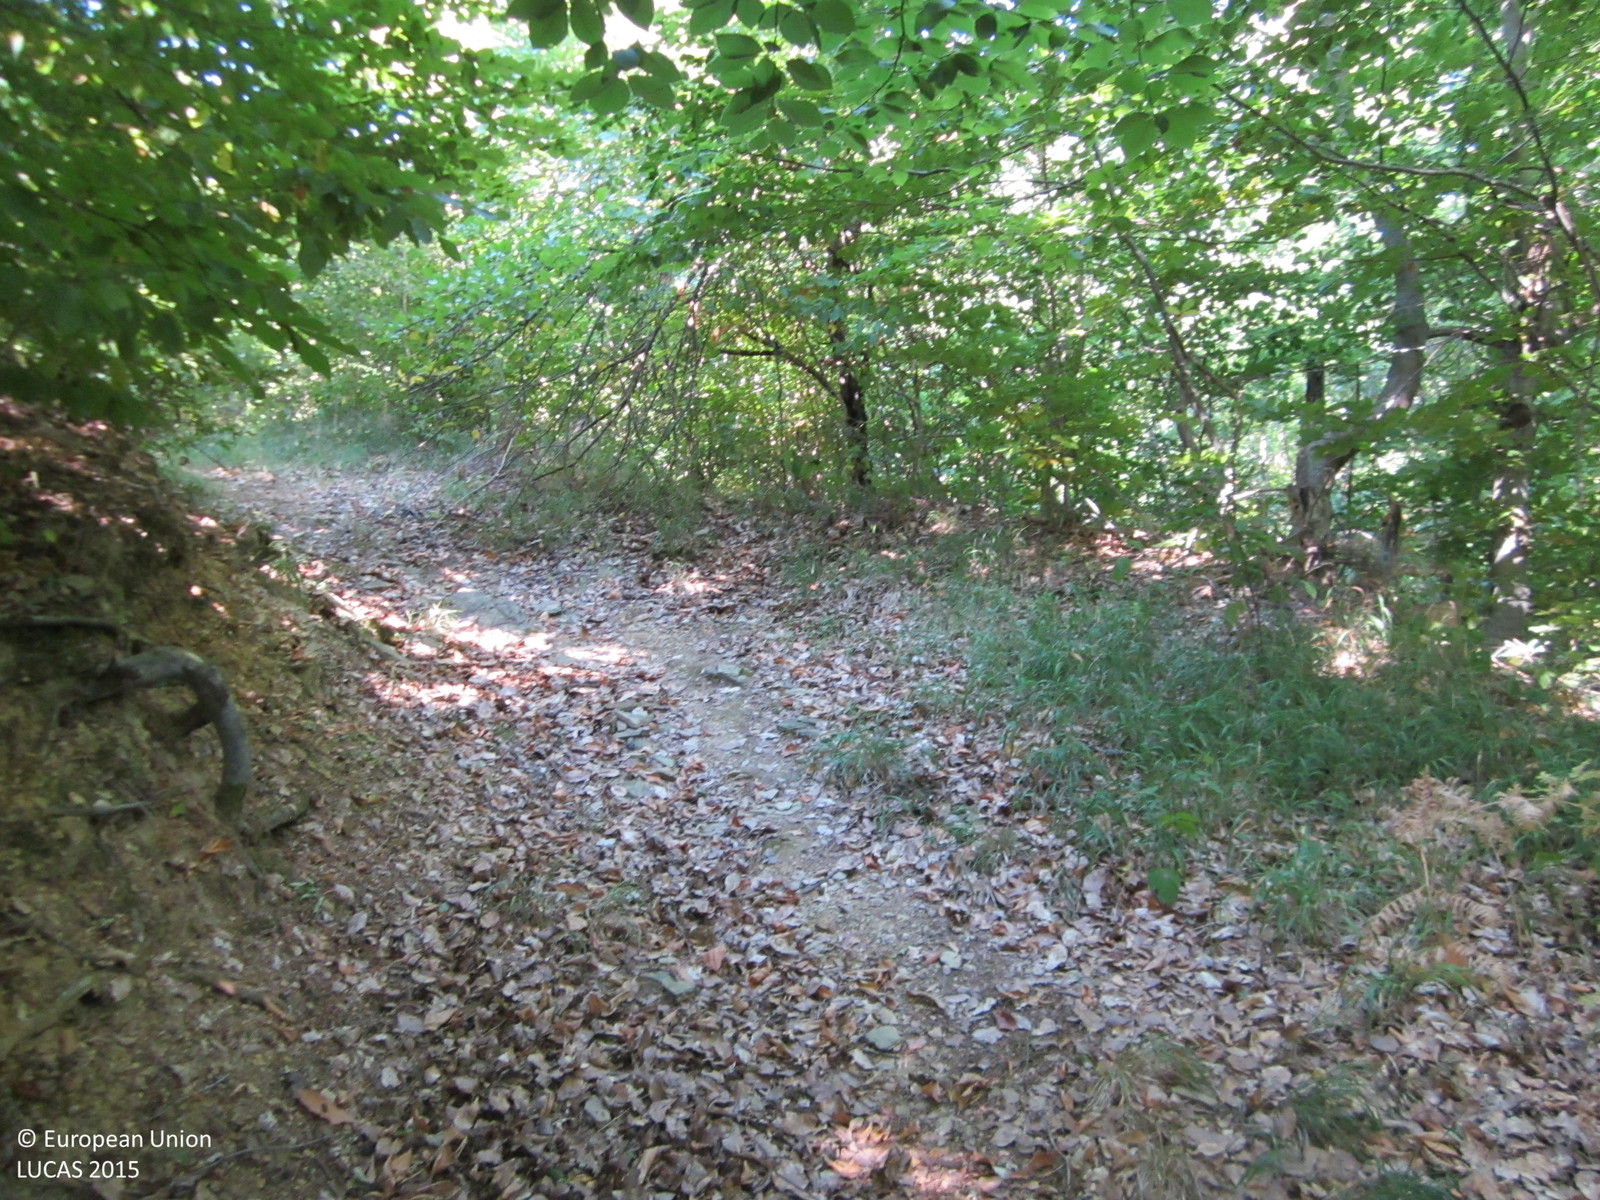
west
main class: Woodland
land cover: Broadleaved woodland
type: thermophilous deciduous forest
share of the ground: > 75 %
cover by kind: broadleaved forest trees 90 %, lichens and mosses 5 %, unconsolidated bare surface 5 %
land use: Forestry
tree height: > 5 m
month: August
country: BG
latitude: 42.0890
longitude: 27.7330
